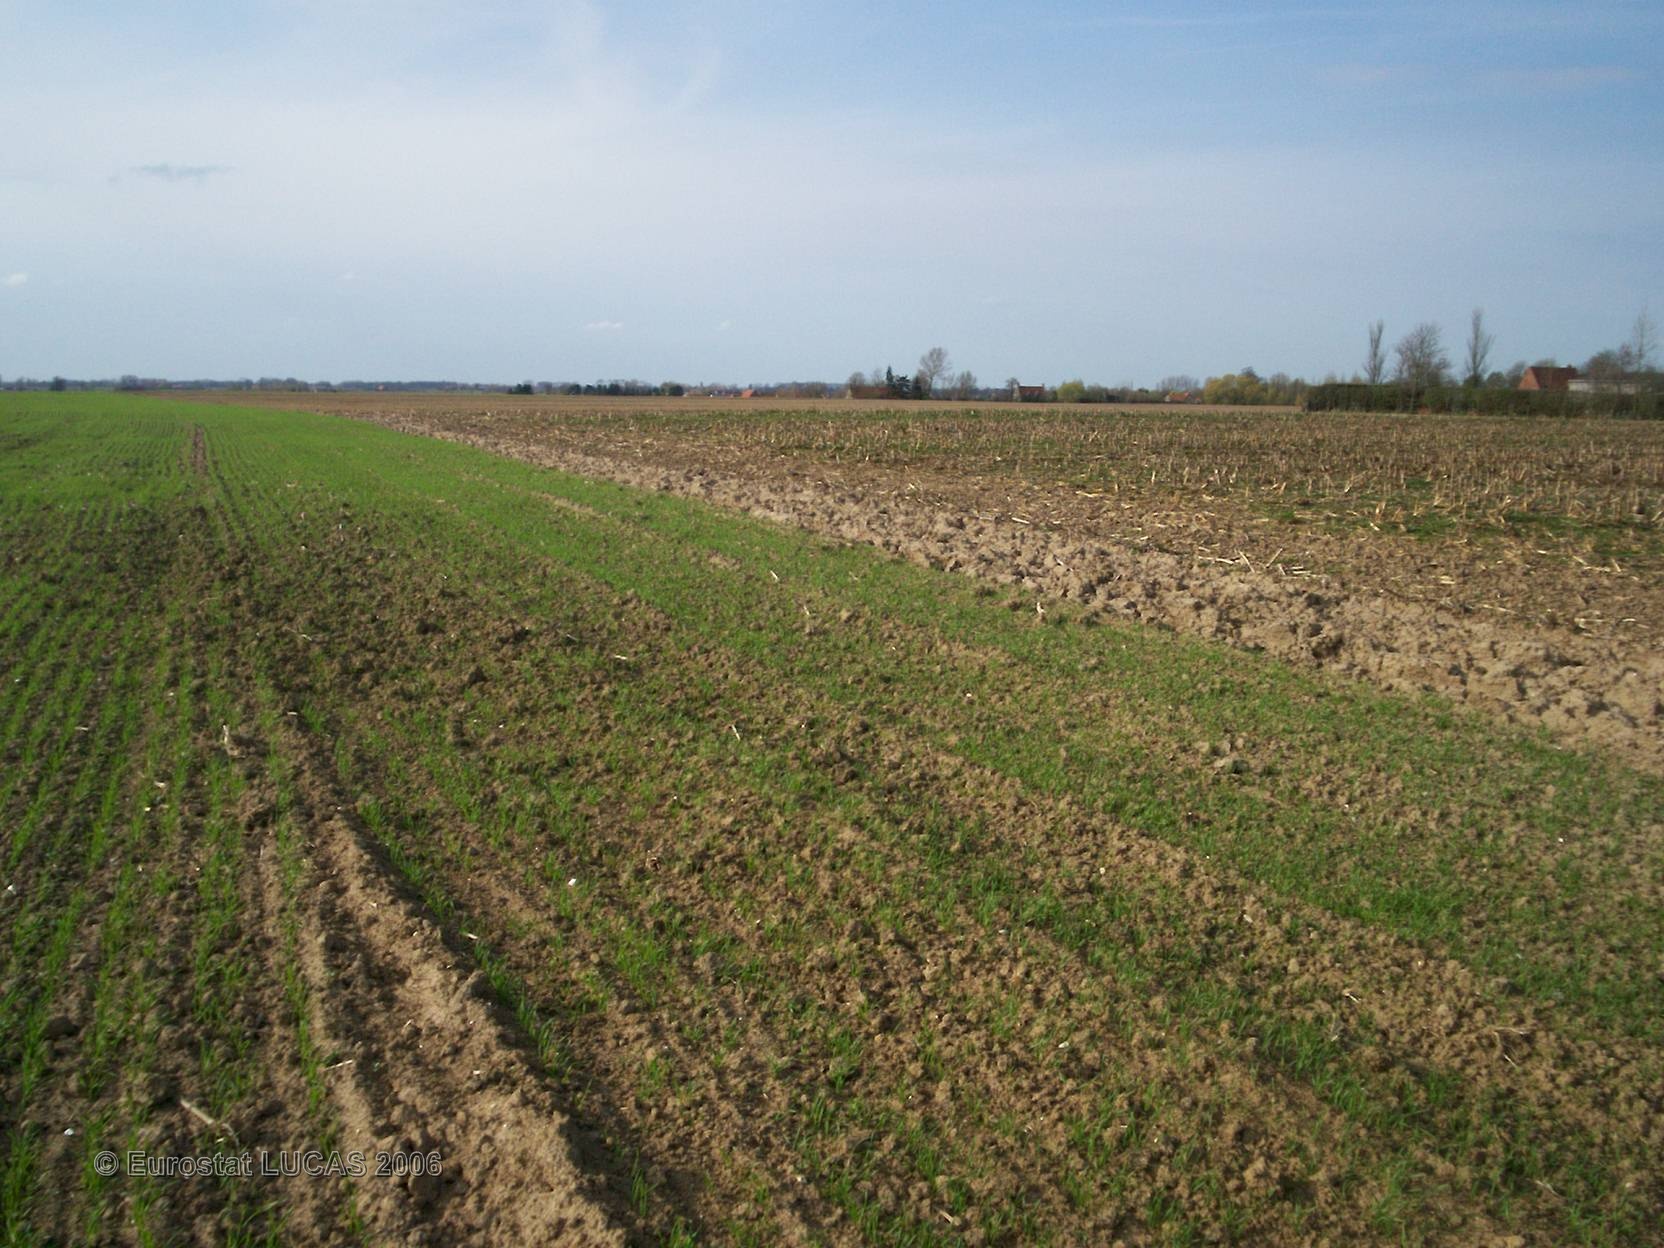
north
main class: Cropland
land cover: Common wheat
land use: Agriculture (excluding fallow land and kitchen gardens)
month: April
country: FR
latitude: 50.8384
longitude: 2.4751
